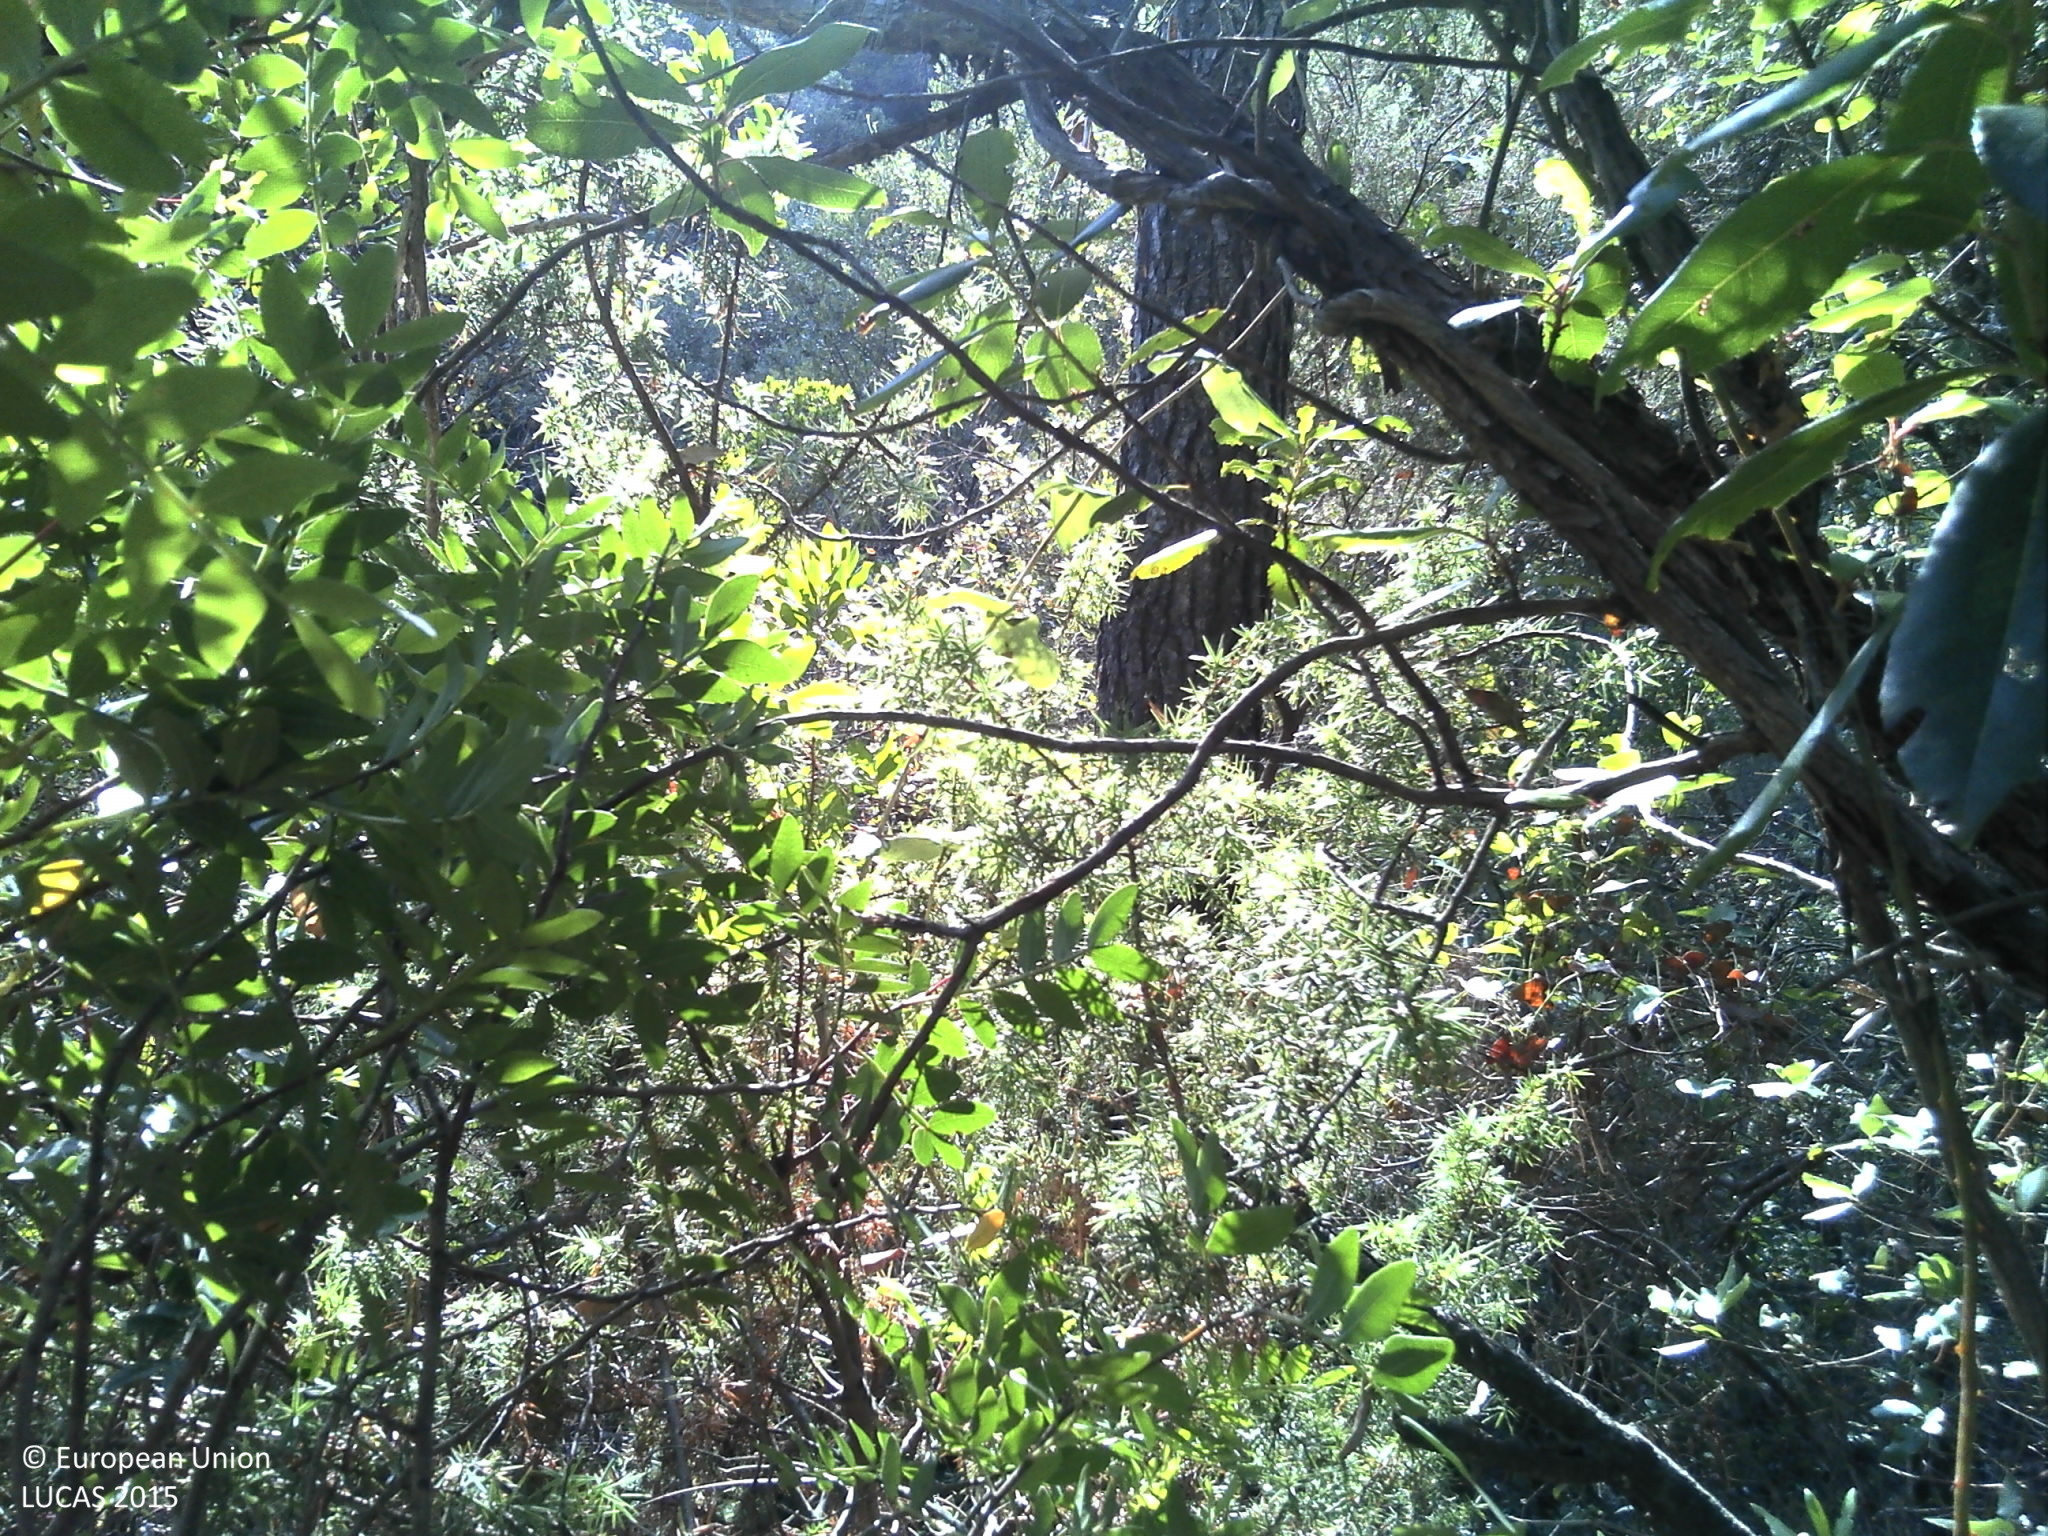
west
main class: Woodland
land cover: Pine dominated mixed woodland
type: coniferous forest of the mediterranean region
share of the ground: > 75 %
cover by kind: shrubs 50 %, coniferous forest trees 25 %, broadleaved forest trees 10 %, consolidated bare surface 10 %, lichens and mosses 5 %
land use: Semi-natural and natural areas not in use
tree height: > 5 m
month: August
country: HR
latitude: 43.1440
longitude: 16.8876
